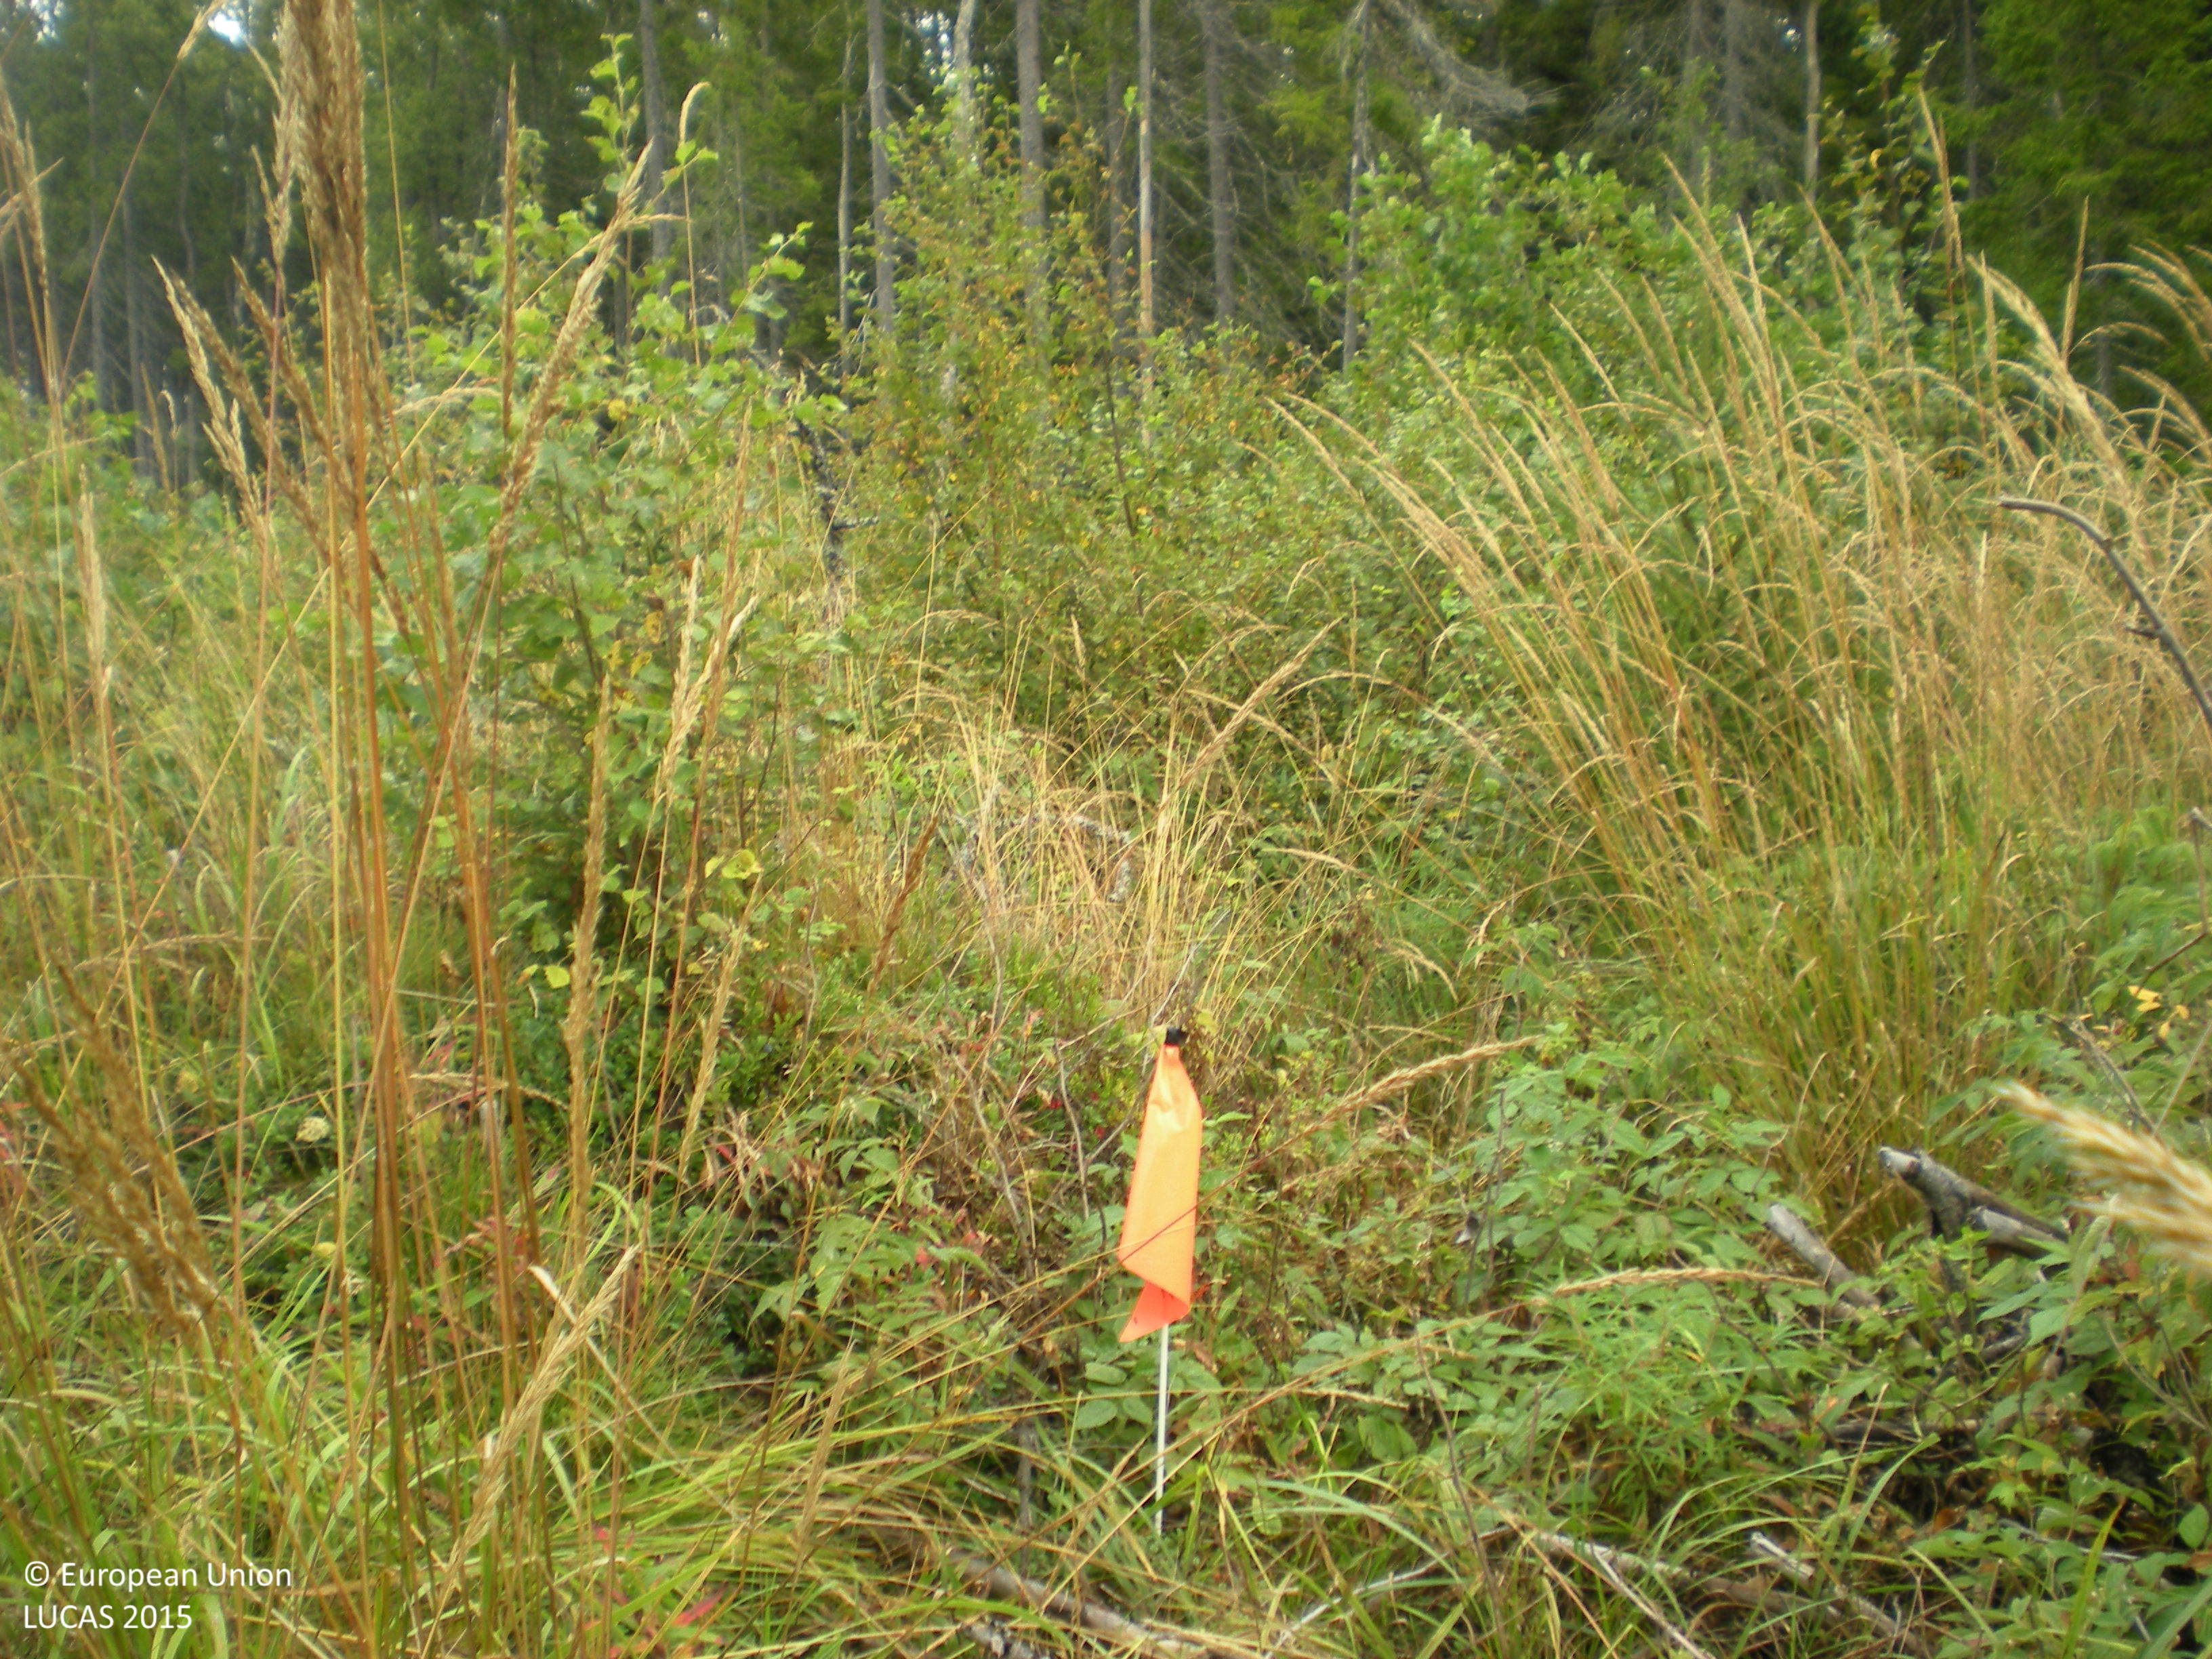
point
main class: Woodland
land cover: Spruce dominated mixed woodland
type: boreal forest
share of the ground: 50 - 75 %
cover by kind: broadleaved forest trees 35 %, coniferous forest trees 30 %, herbaceous plants 25 %, shrubs 5 %, lichens and mosses 5 %
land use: Forestry
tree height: < 5 m
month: August
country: SE
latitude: 60.4807
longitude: 17.2864
